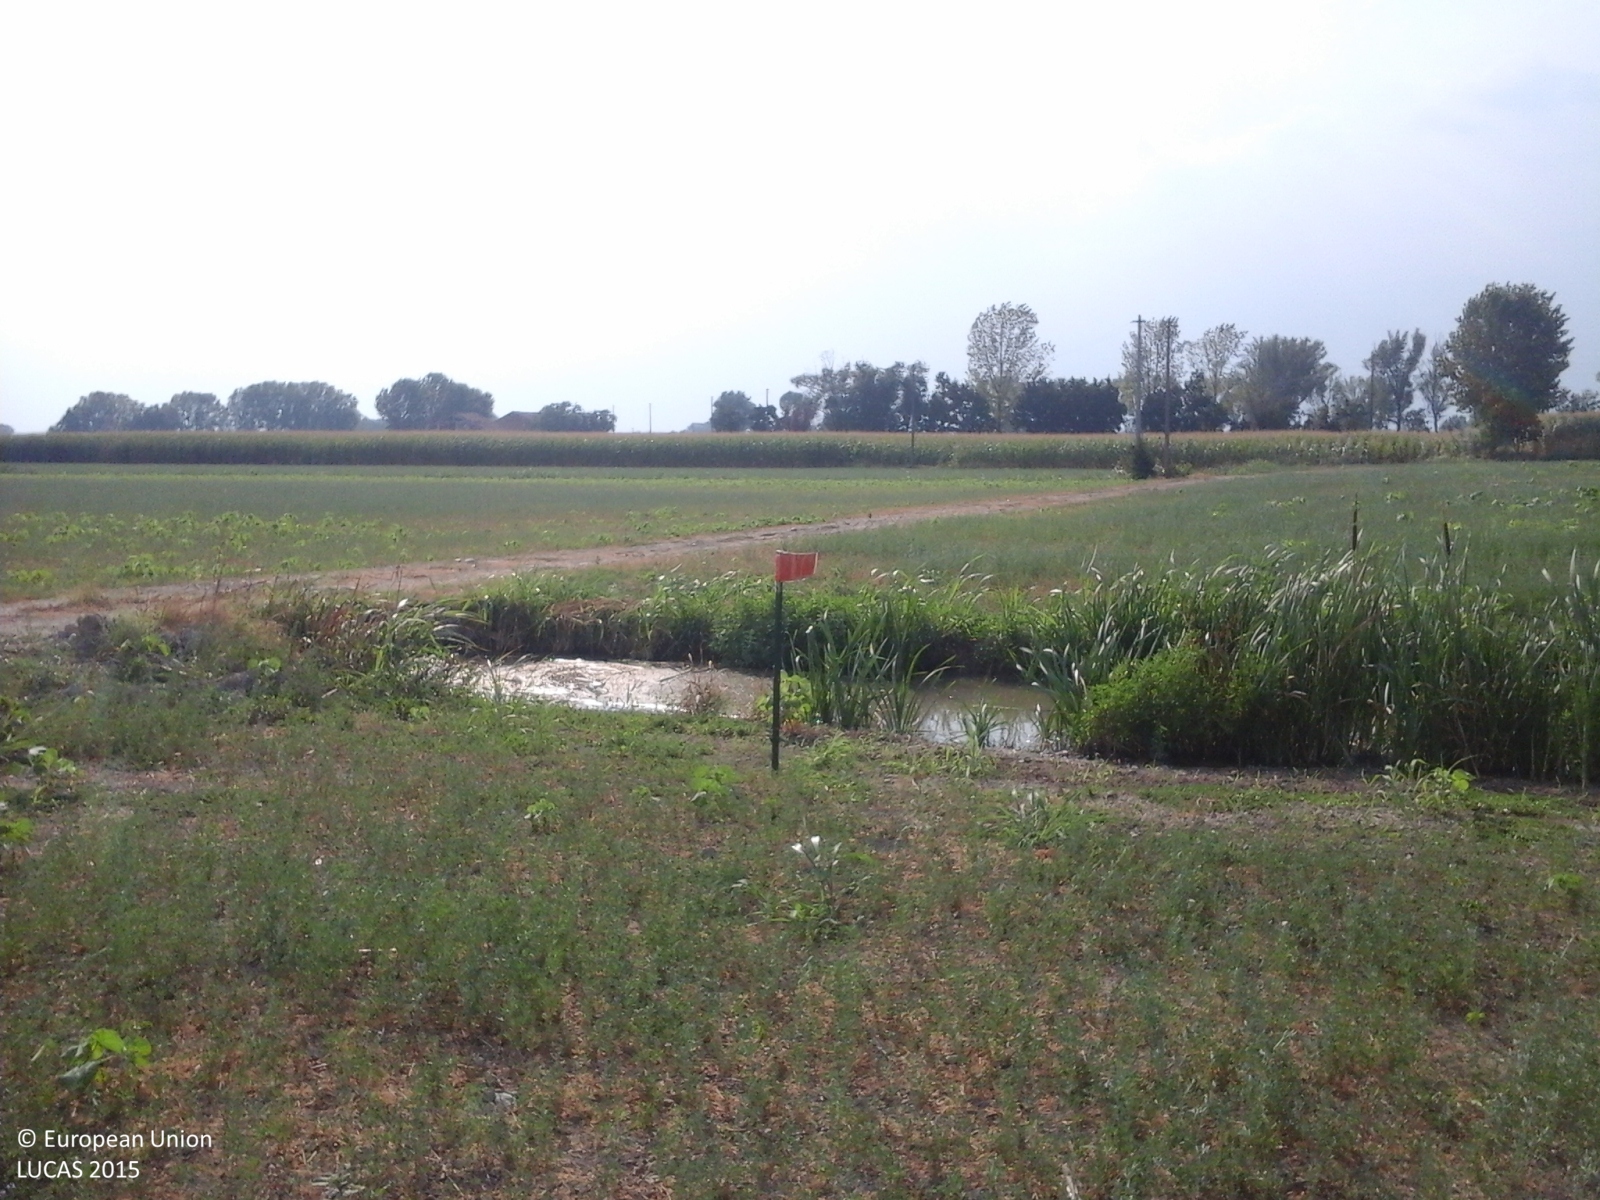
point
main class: Cropland
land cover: Lucerne
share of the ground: 25 - 50 %
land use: Agriculture (excluding fallow land and kitchen gardens)
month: July
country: IT
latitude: 44.9426
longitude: 10.7968
